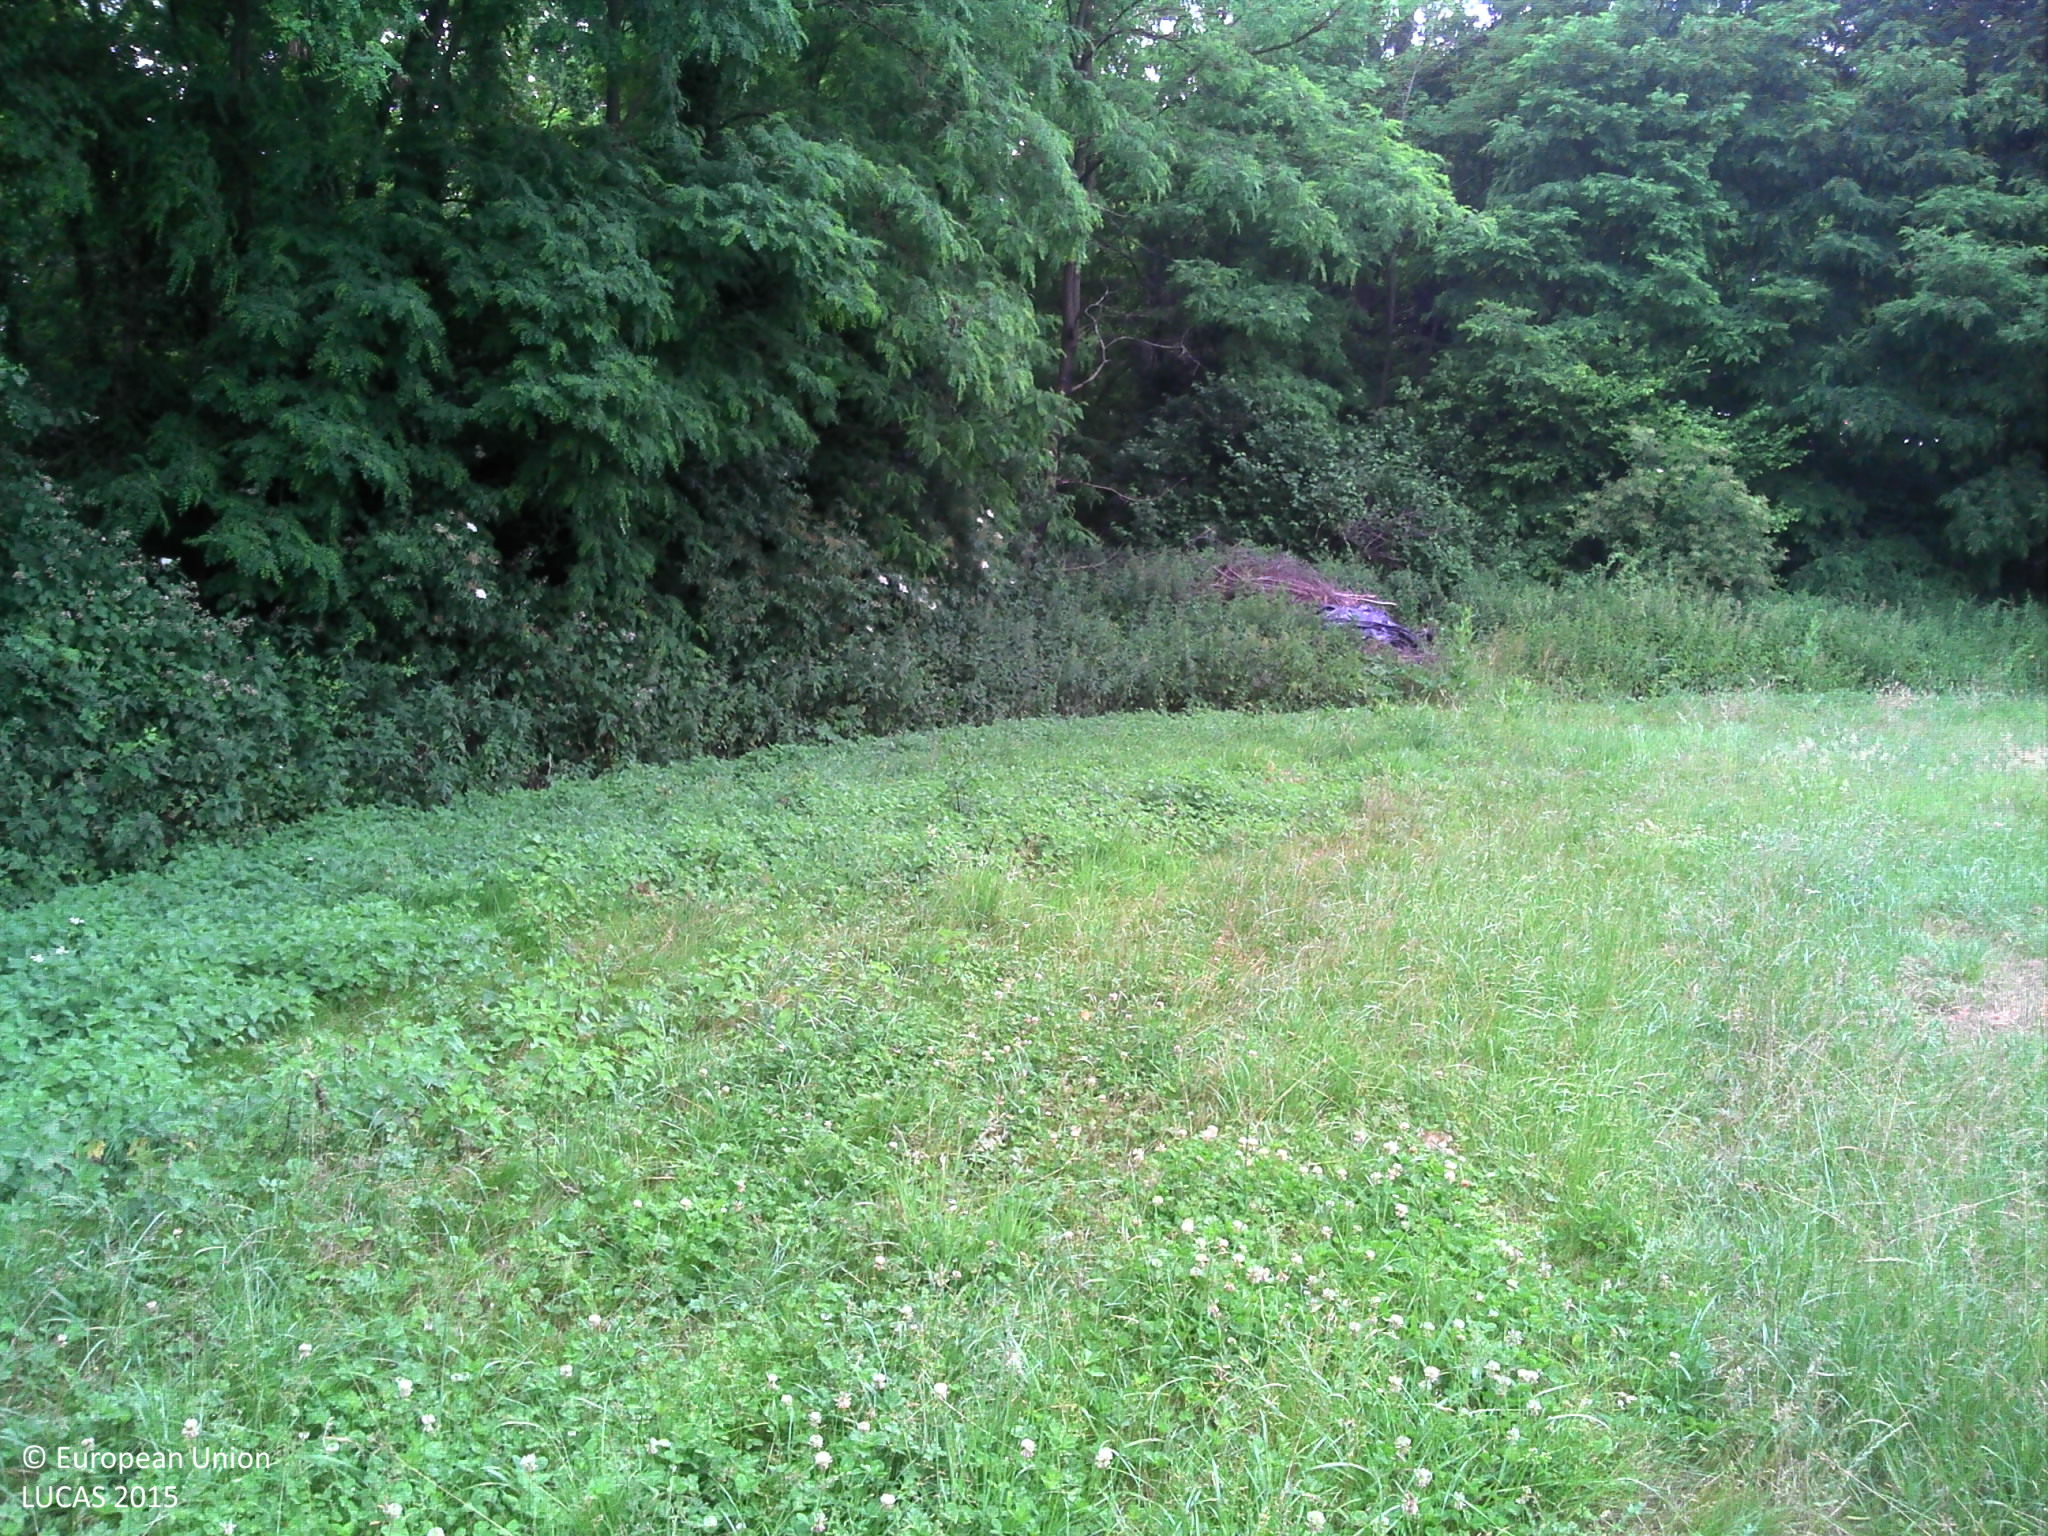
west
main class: Grassland
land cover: Grassland without tree/shrub cover
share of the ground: > 75 %
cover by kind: herbaceous plants 100 %
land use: Agriculture (excluding fallow land and kitchen gardens)
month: June
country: FR
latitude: 46.0645
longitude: 4.8448
